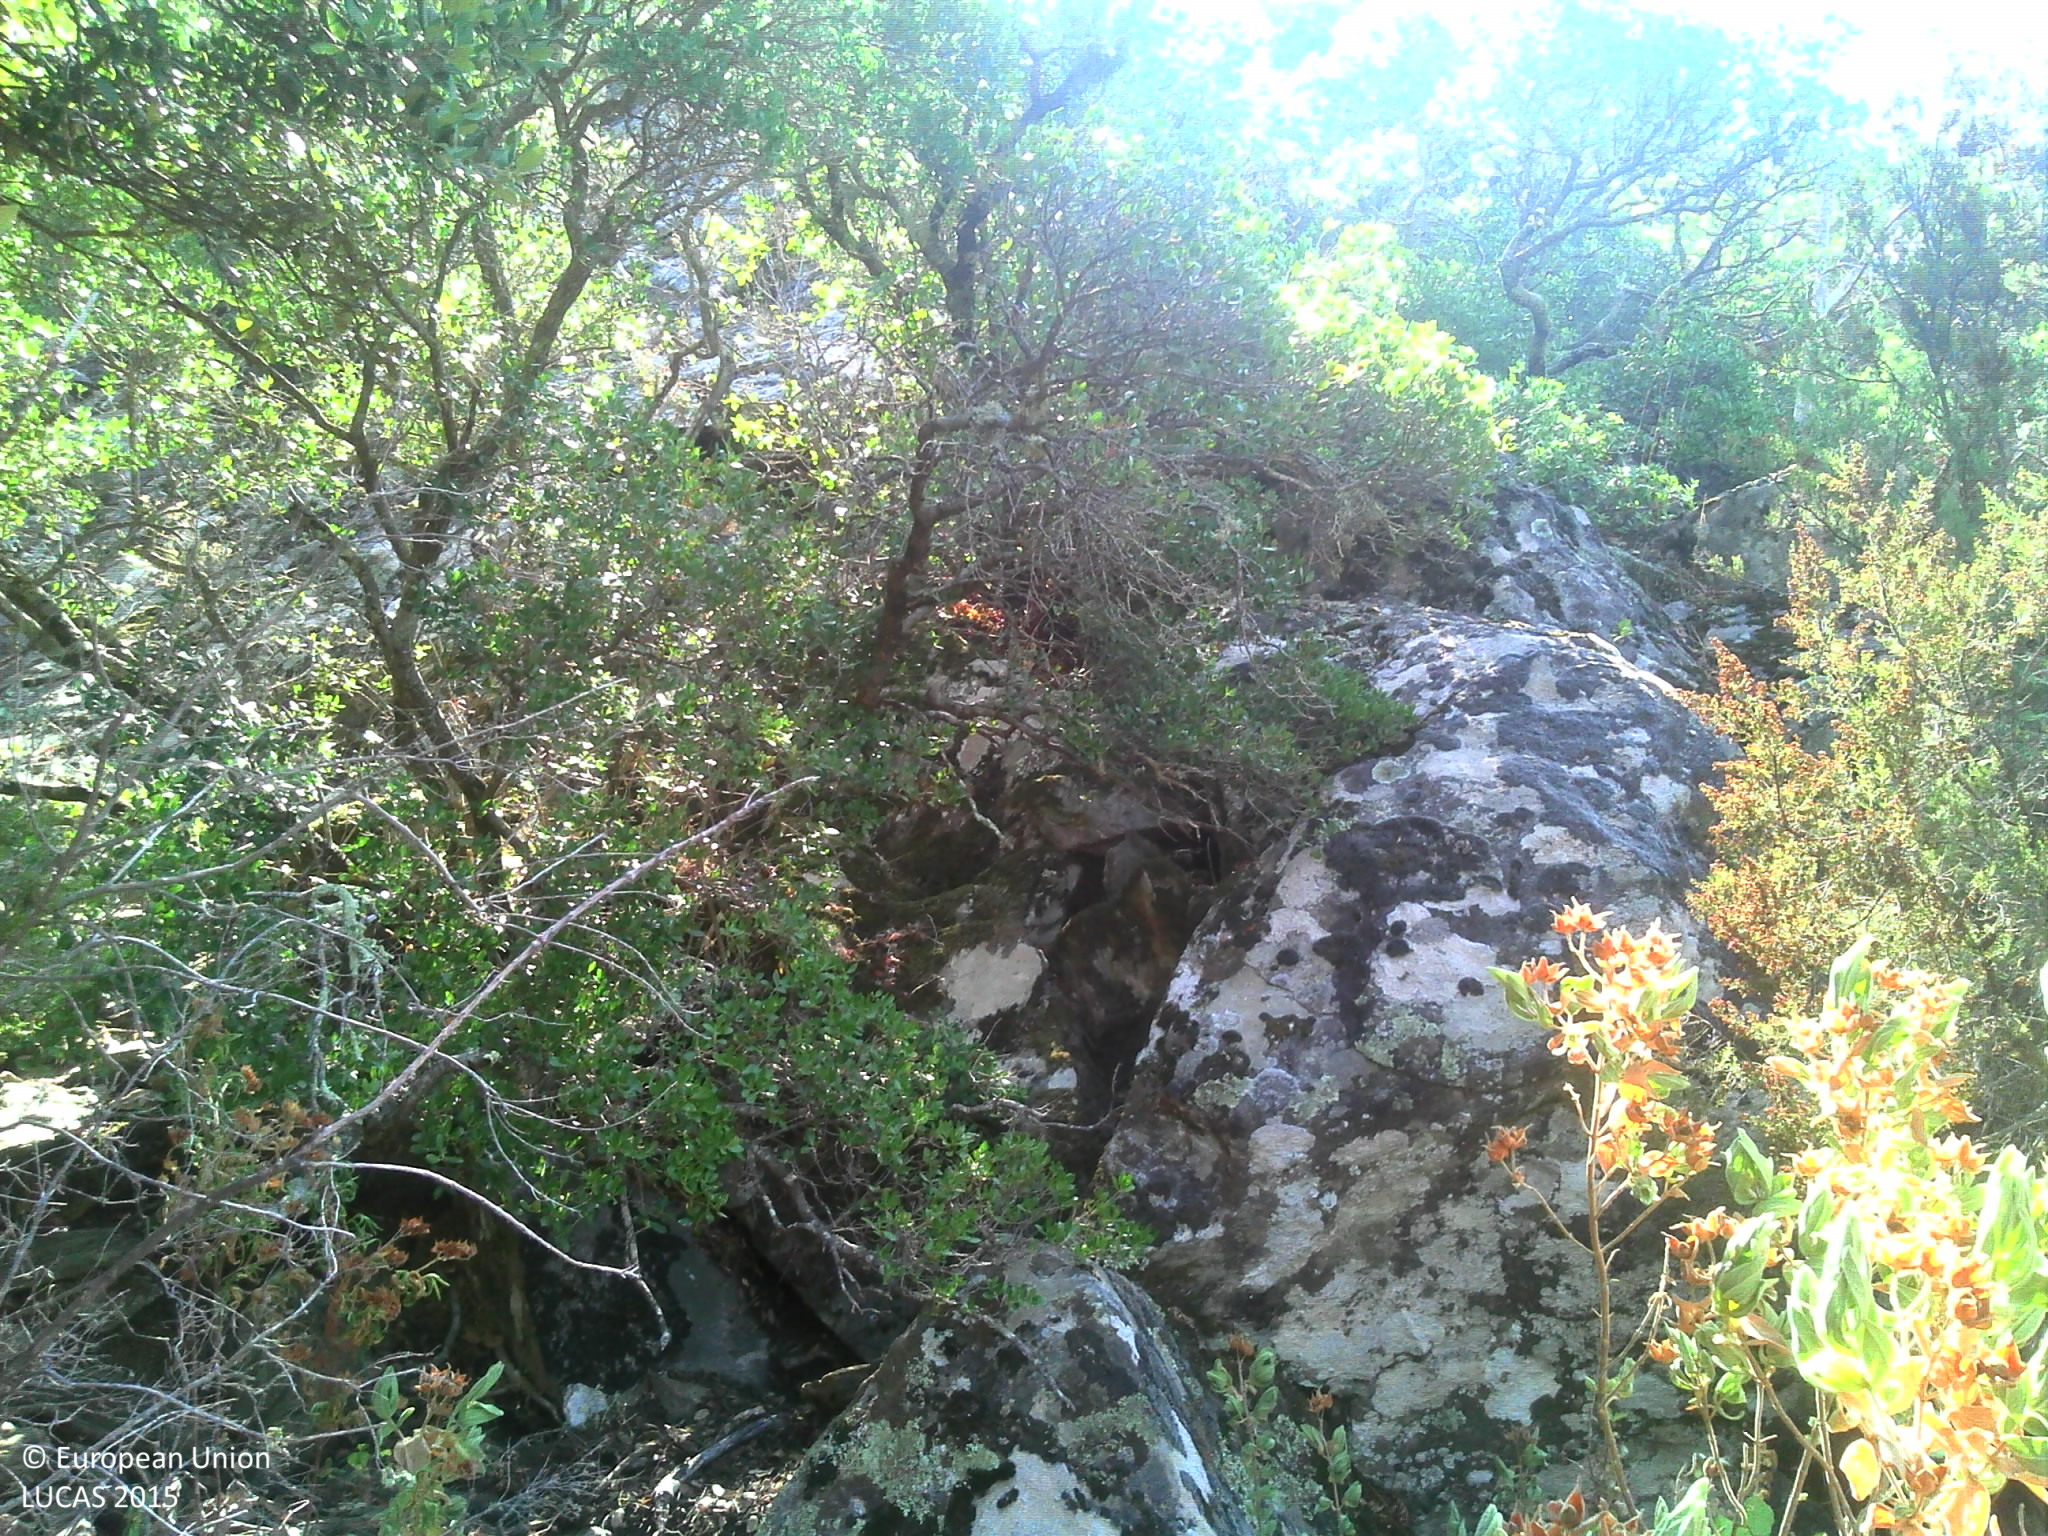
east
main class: Woodland
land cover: Broadleaved woodland
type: thermophilous deciduous forest
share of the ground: > 75 %
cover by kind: broadleaved forest trees 80 %, unconsolidated bare surface 20 %
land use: Semi-natural and natural areas not in use
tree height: > 5 m
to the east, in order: Broadleaved woodland
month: July
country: FR
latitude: 43.2570
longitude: 6.3508
